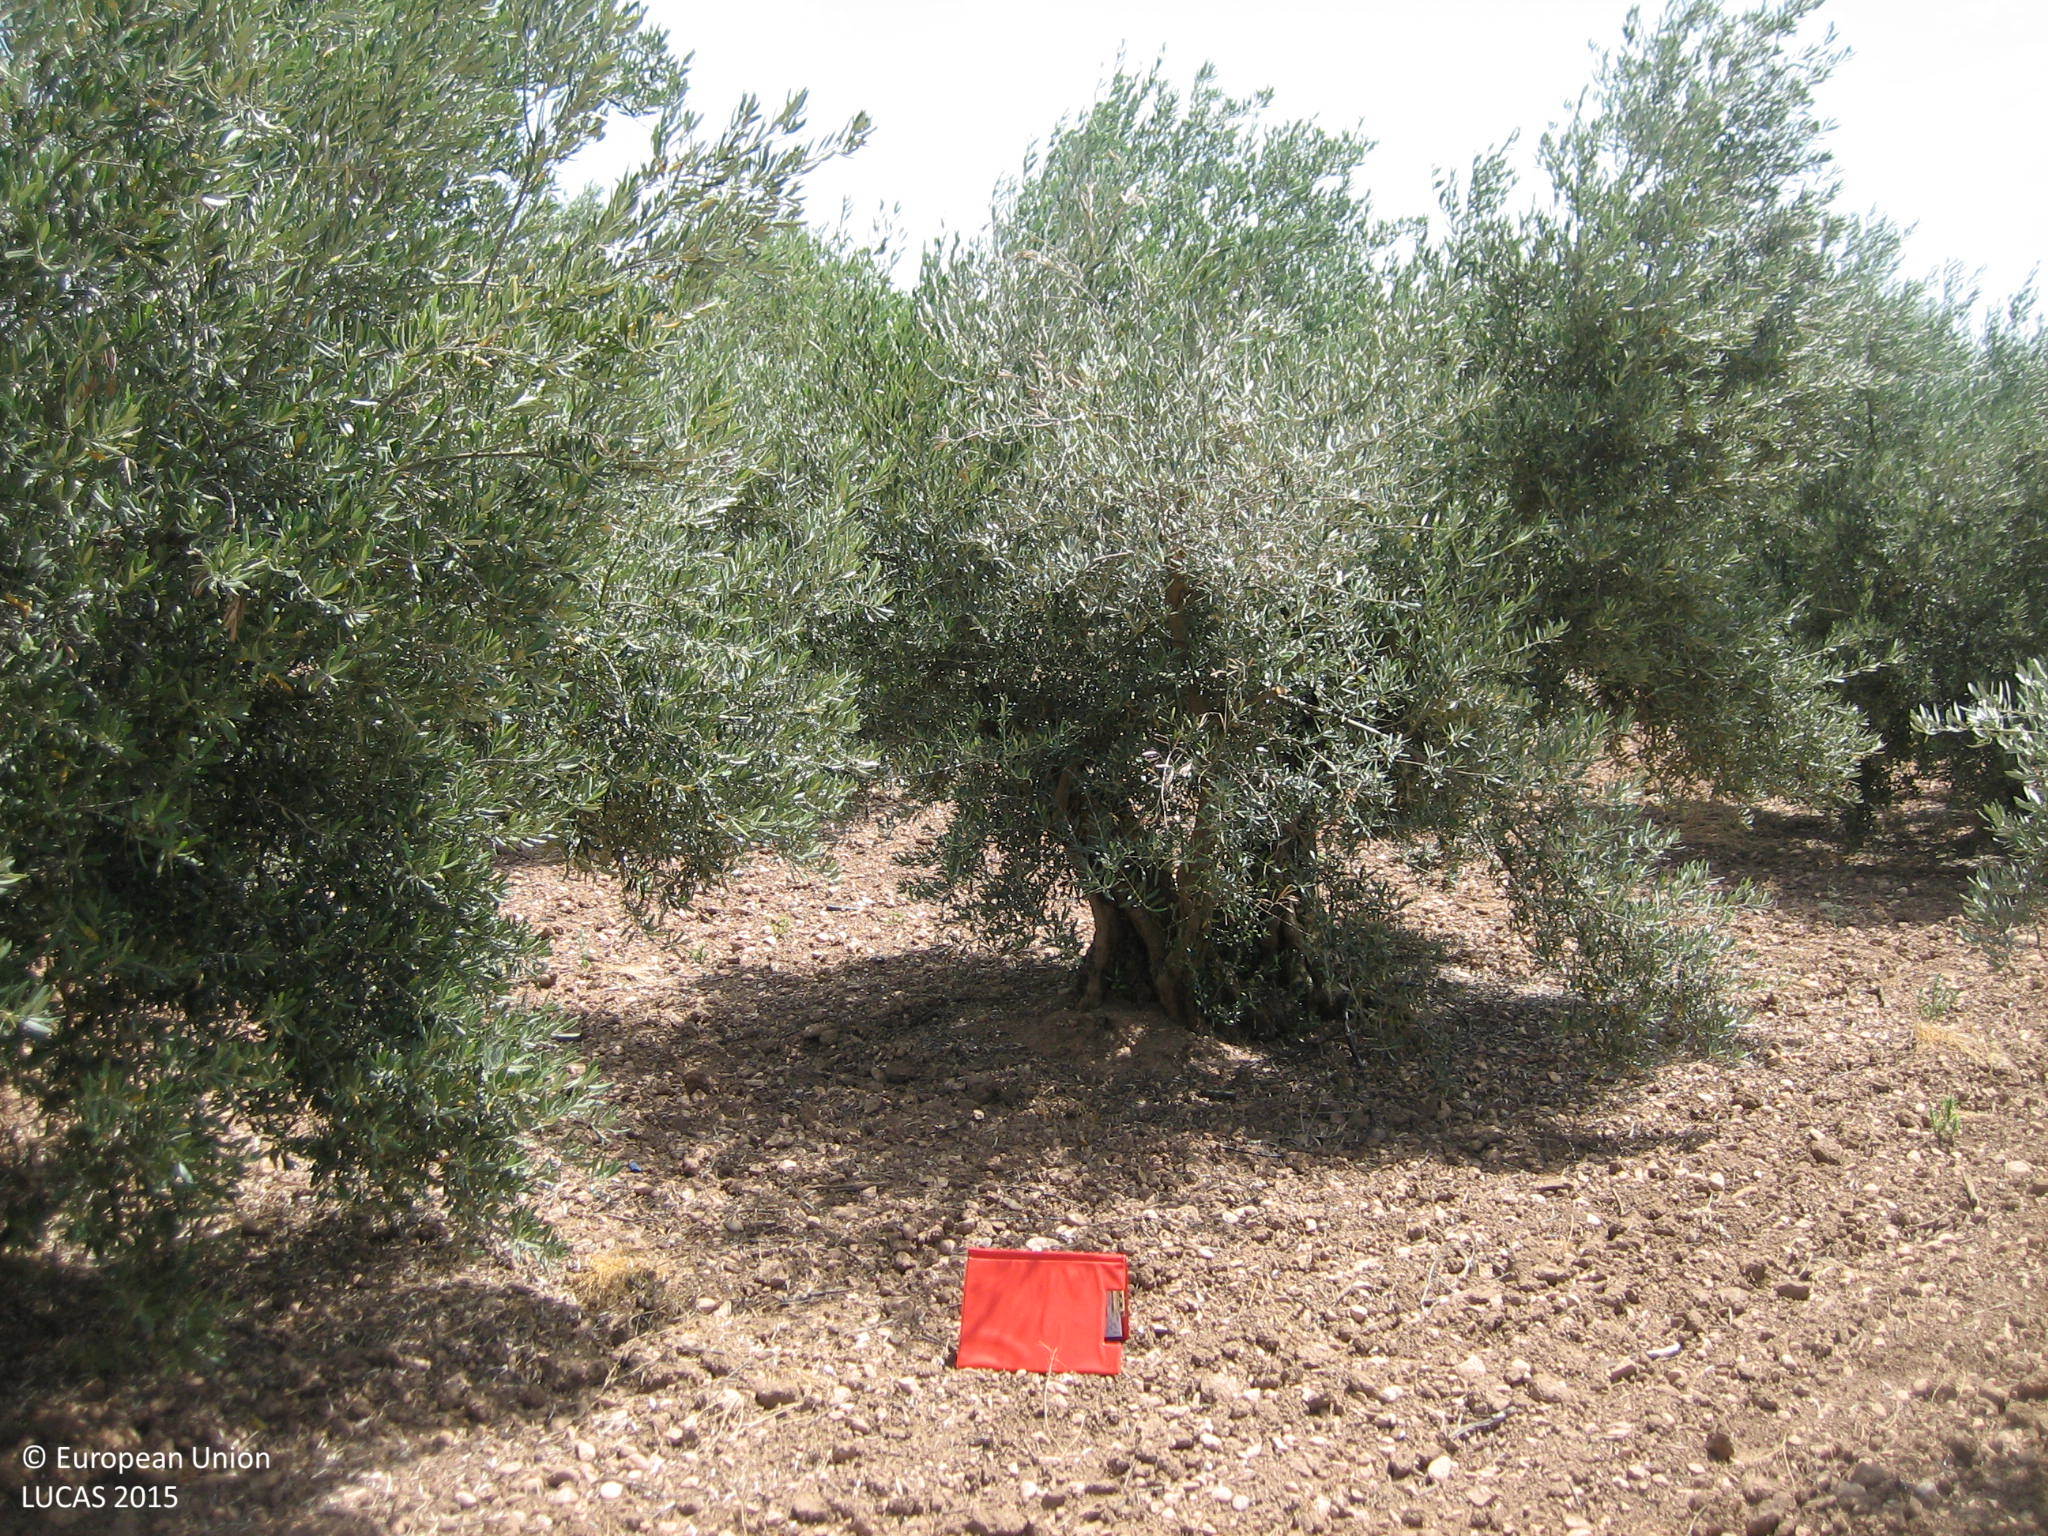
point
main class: Cropland
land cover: Olive groves
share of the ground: 10 - 25 %
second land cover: Other bare soil
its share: > 75 %
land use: Agriculture (excluding fallow land and kitchen gardens)
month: July
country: ES
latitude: 37.6621
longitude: -2.9710
